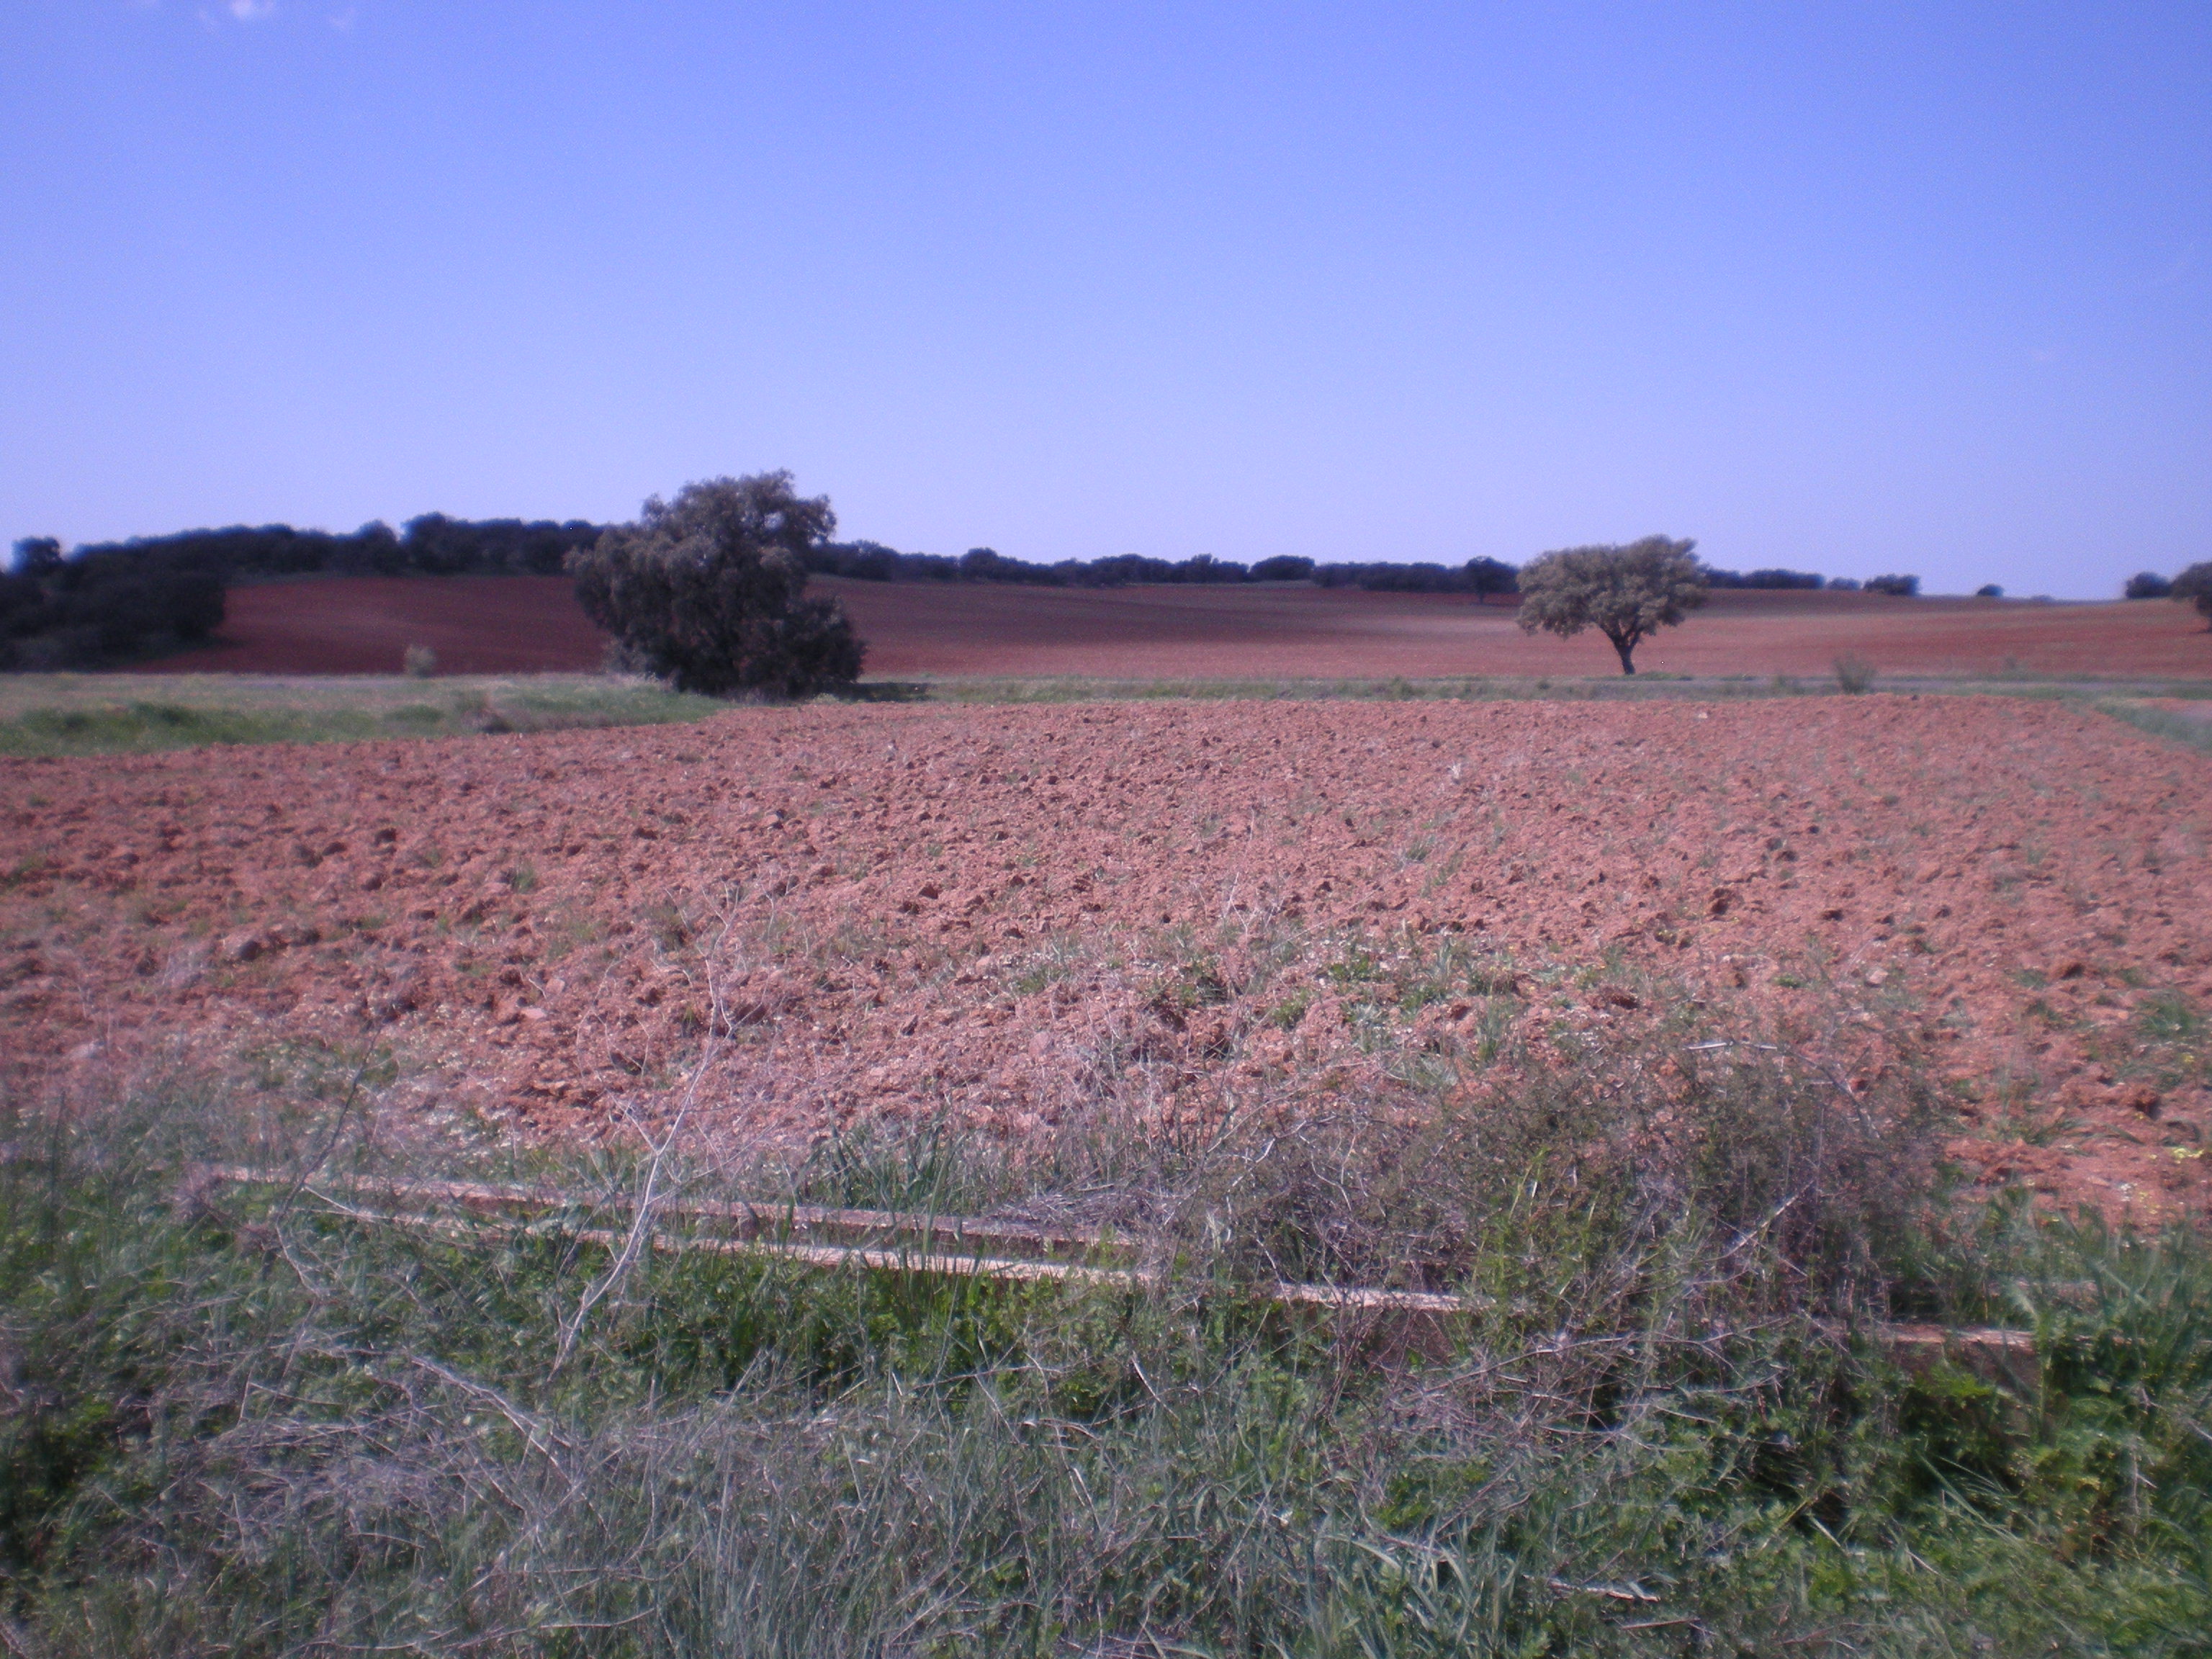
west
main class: Grassland
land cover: Grassland without tree/shrub cover
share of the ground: > 75 %
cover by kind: herbaceous plants 100 %
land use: Semi-natural and natural areas not in use
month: April
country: ES
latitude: 38.5900
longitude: -3.5460
